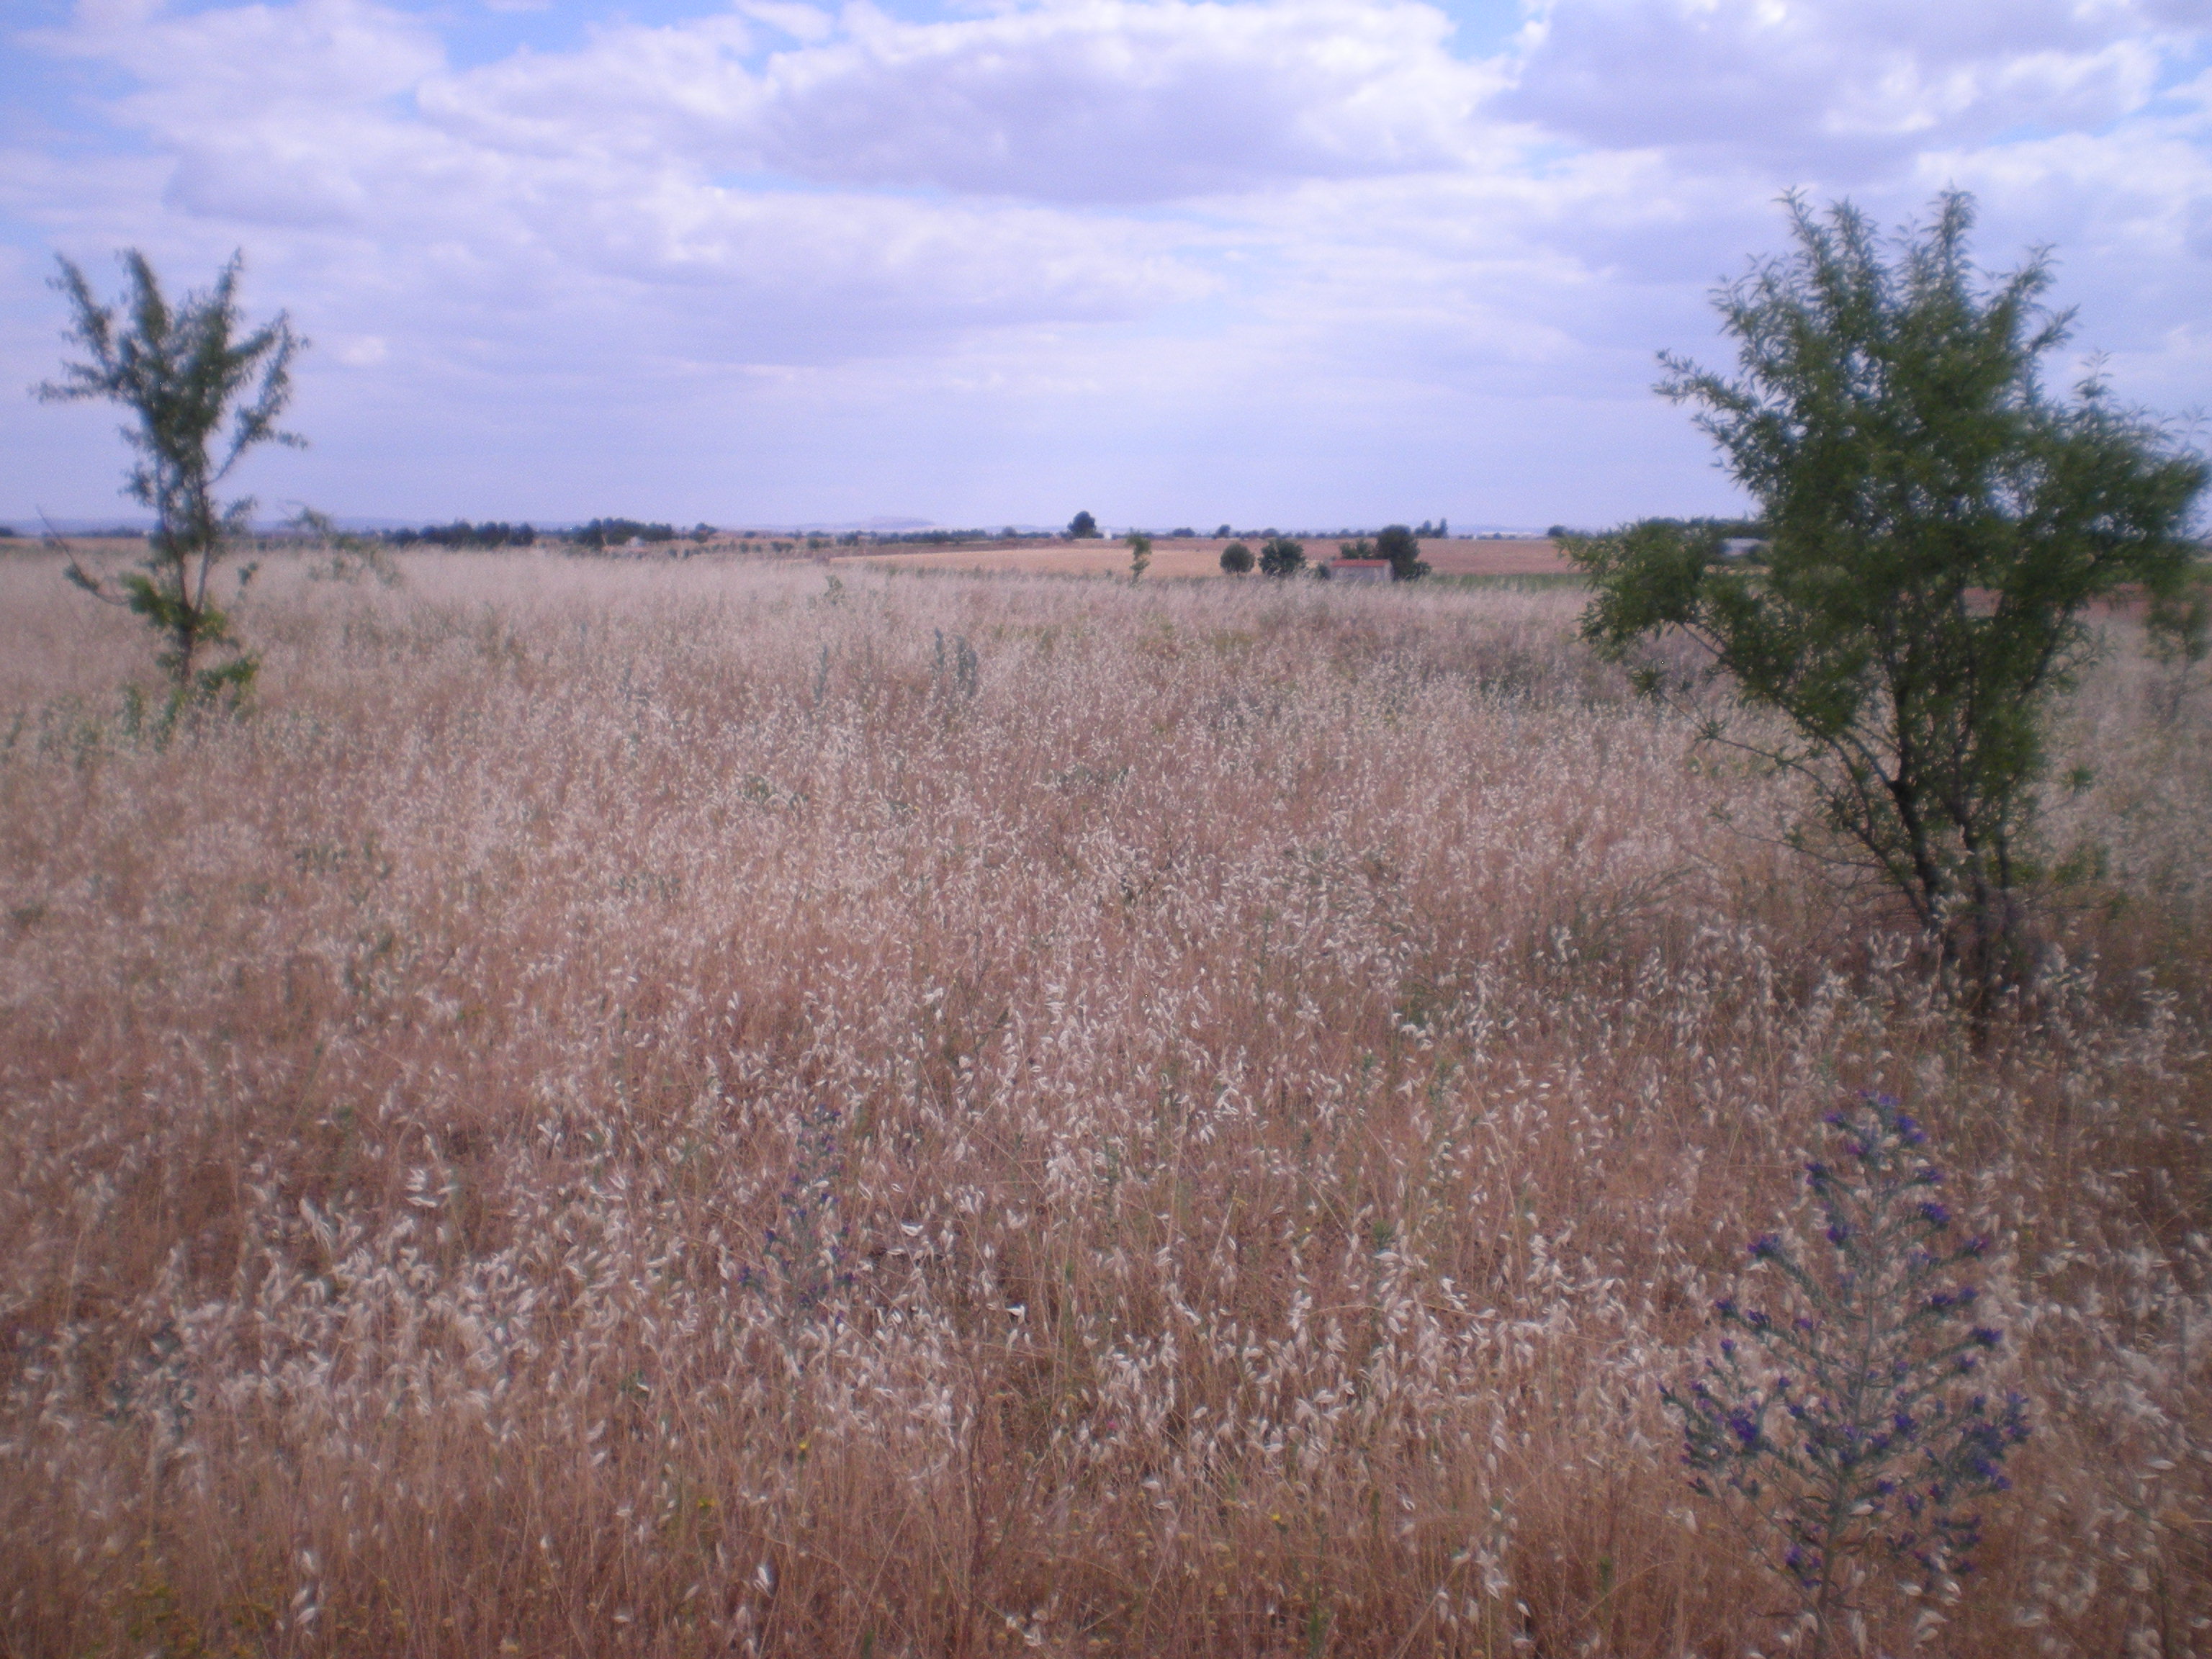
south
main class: Woodland
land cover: Pine dominated mixed woodland
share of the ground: 25 - 50 %
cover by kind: coniferous forest trees 30 %, unconsolidated bare surface 30 %, broadleaved forest trees 10 %, shrubs 10 %, herbaceous plants 10 %, consolidated bare surface 10 %
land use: Residential
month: May
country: ES
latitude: 39.0708
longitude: -3.6455
